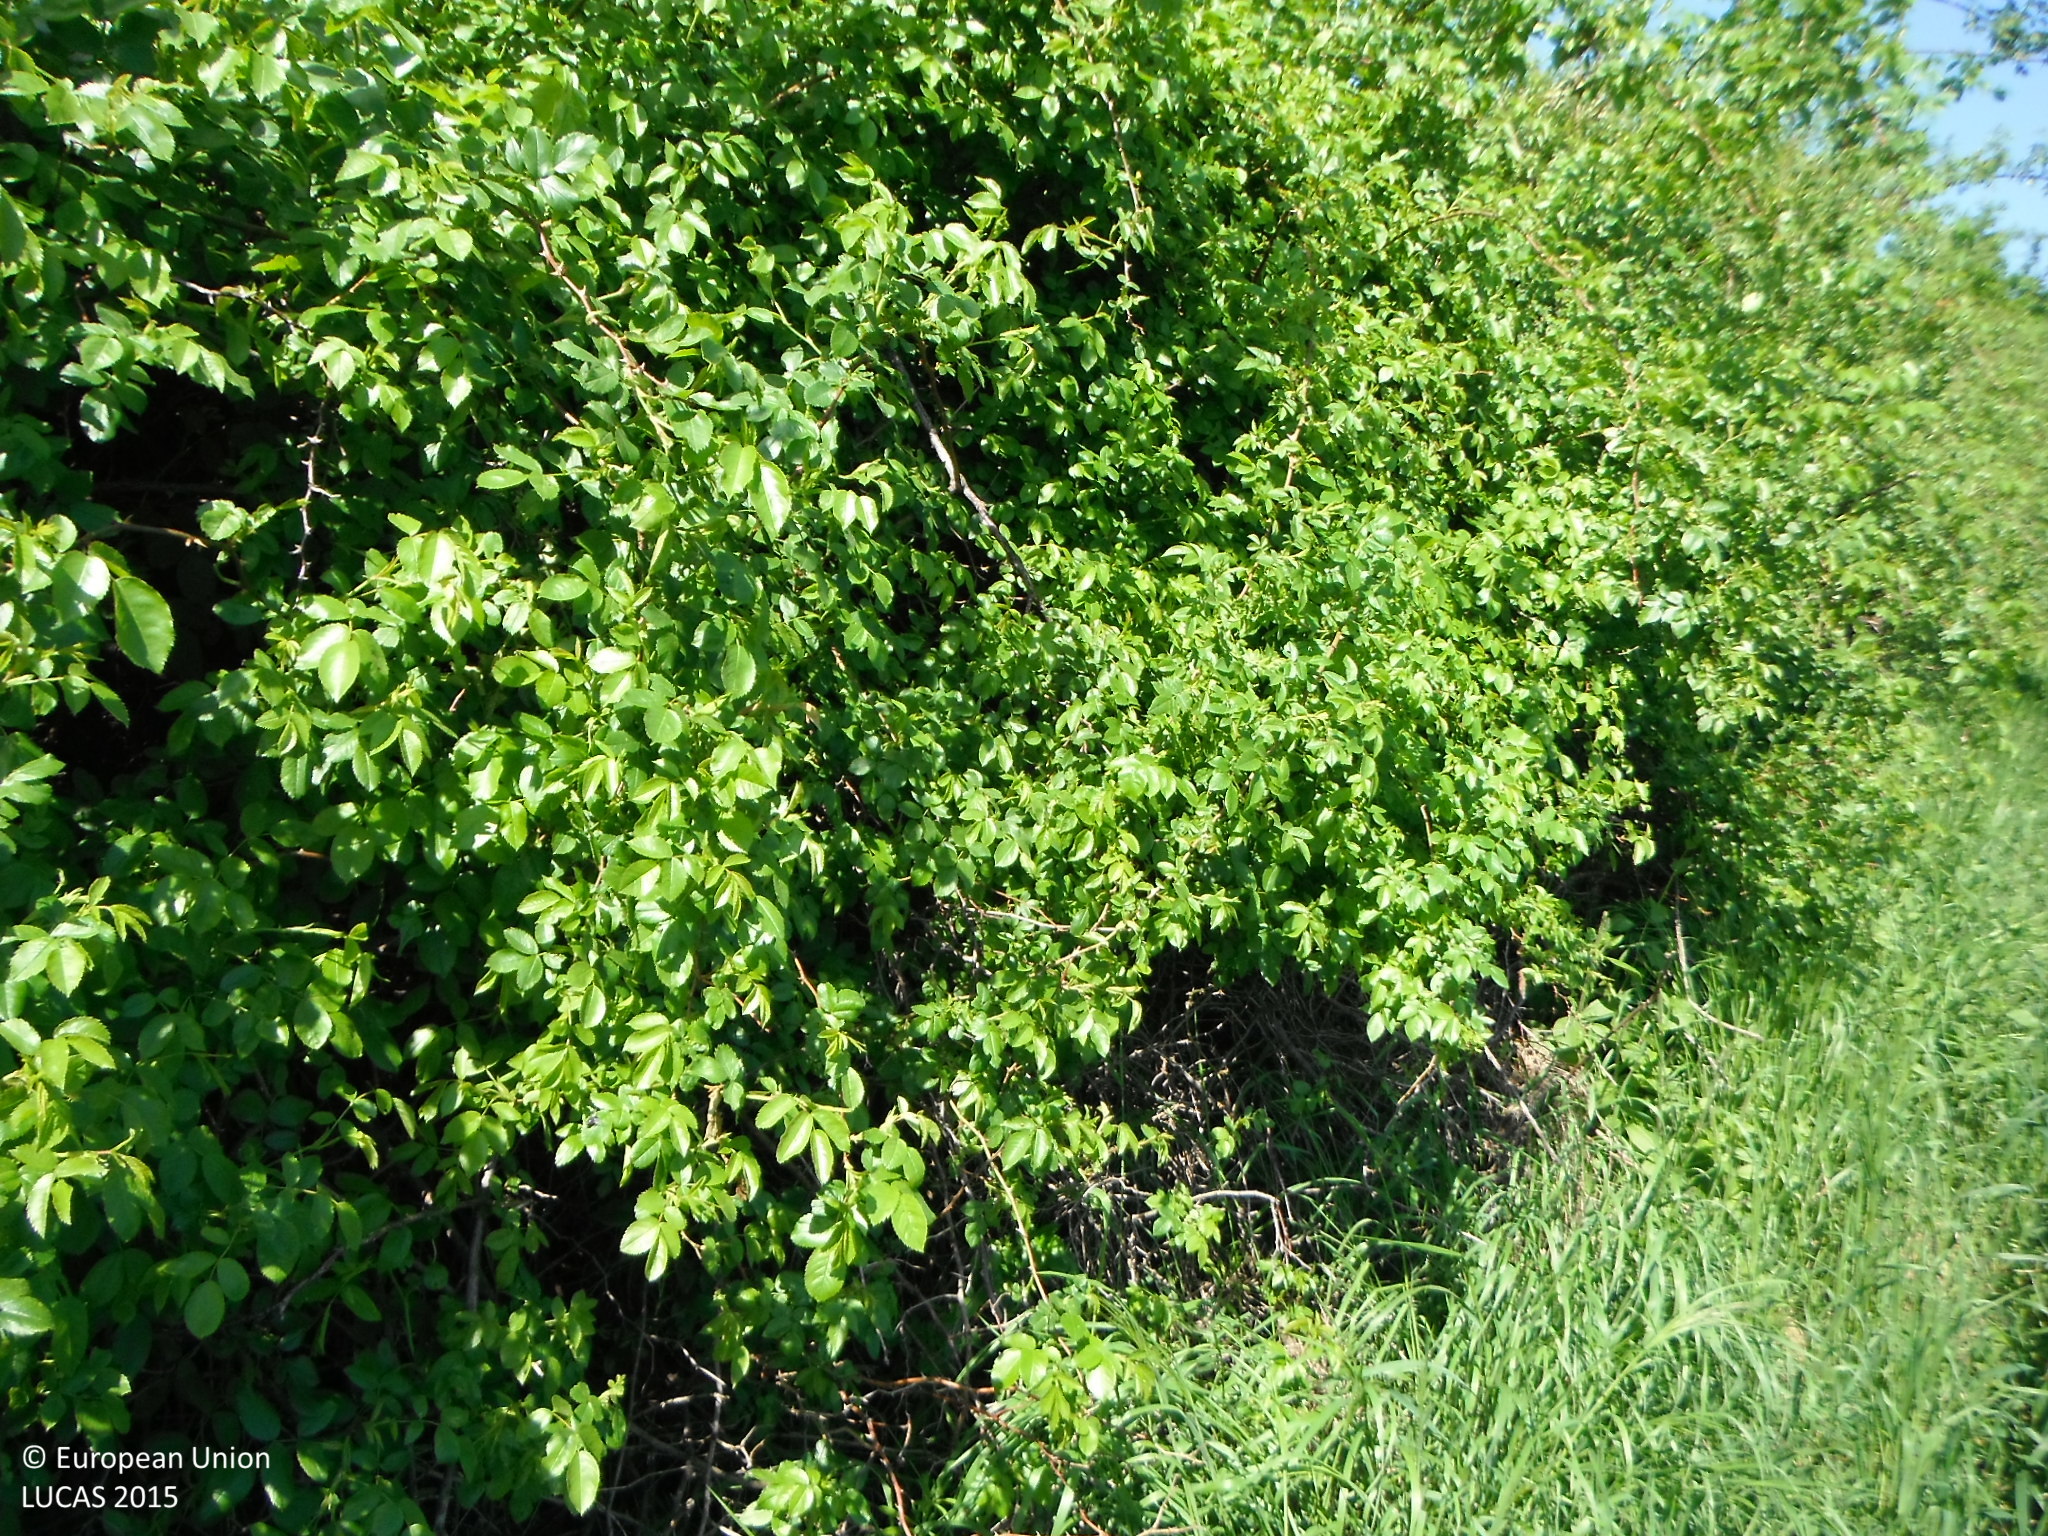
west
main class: Cropland
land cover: Common wheat
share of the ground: > 75 %
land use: Agriculture (excluding fallow land and kitchen gardens)
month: May
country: SK
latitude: 48.3295
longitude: 18.2563
